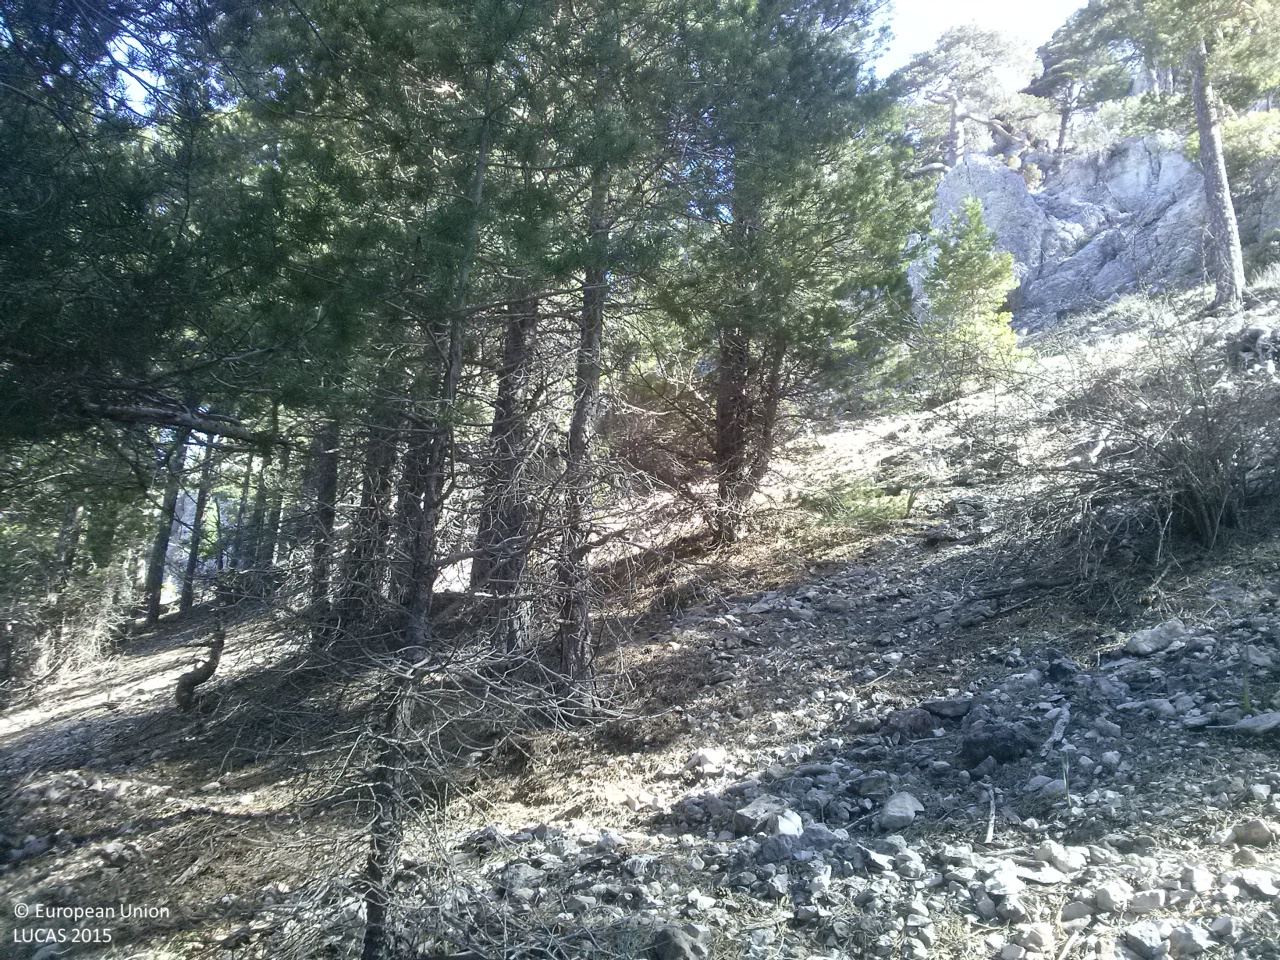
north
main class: Woodland
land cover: Pine dominated coniferous woodland
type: coniferous forest of the mediterranean region
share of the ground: 50 - 75 %
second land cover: Grassland without tree/shrub cover
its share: < 10 %
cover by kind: coniferous forest trees 70 %, unconsolidated bare surface 20 %, herbaceous plants 10 %
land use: Forestry
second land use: Agriculture (excluding fallow land and kitchen gardens)
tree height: > 5 m
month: April
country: ES
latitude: 40.3765
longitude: -1.7826
